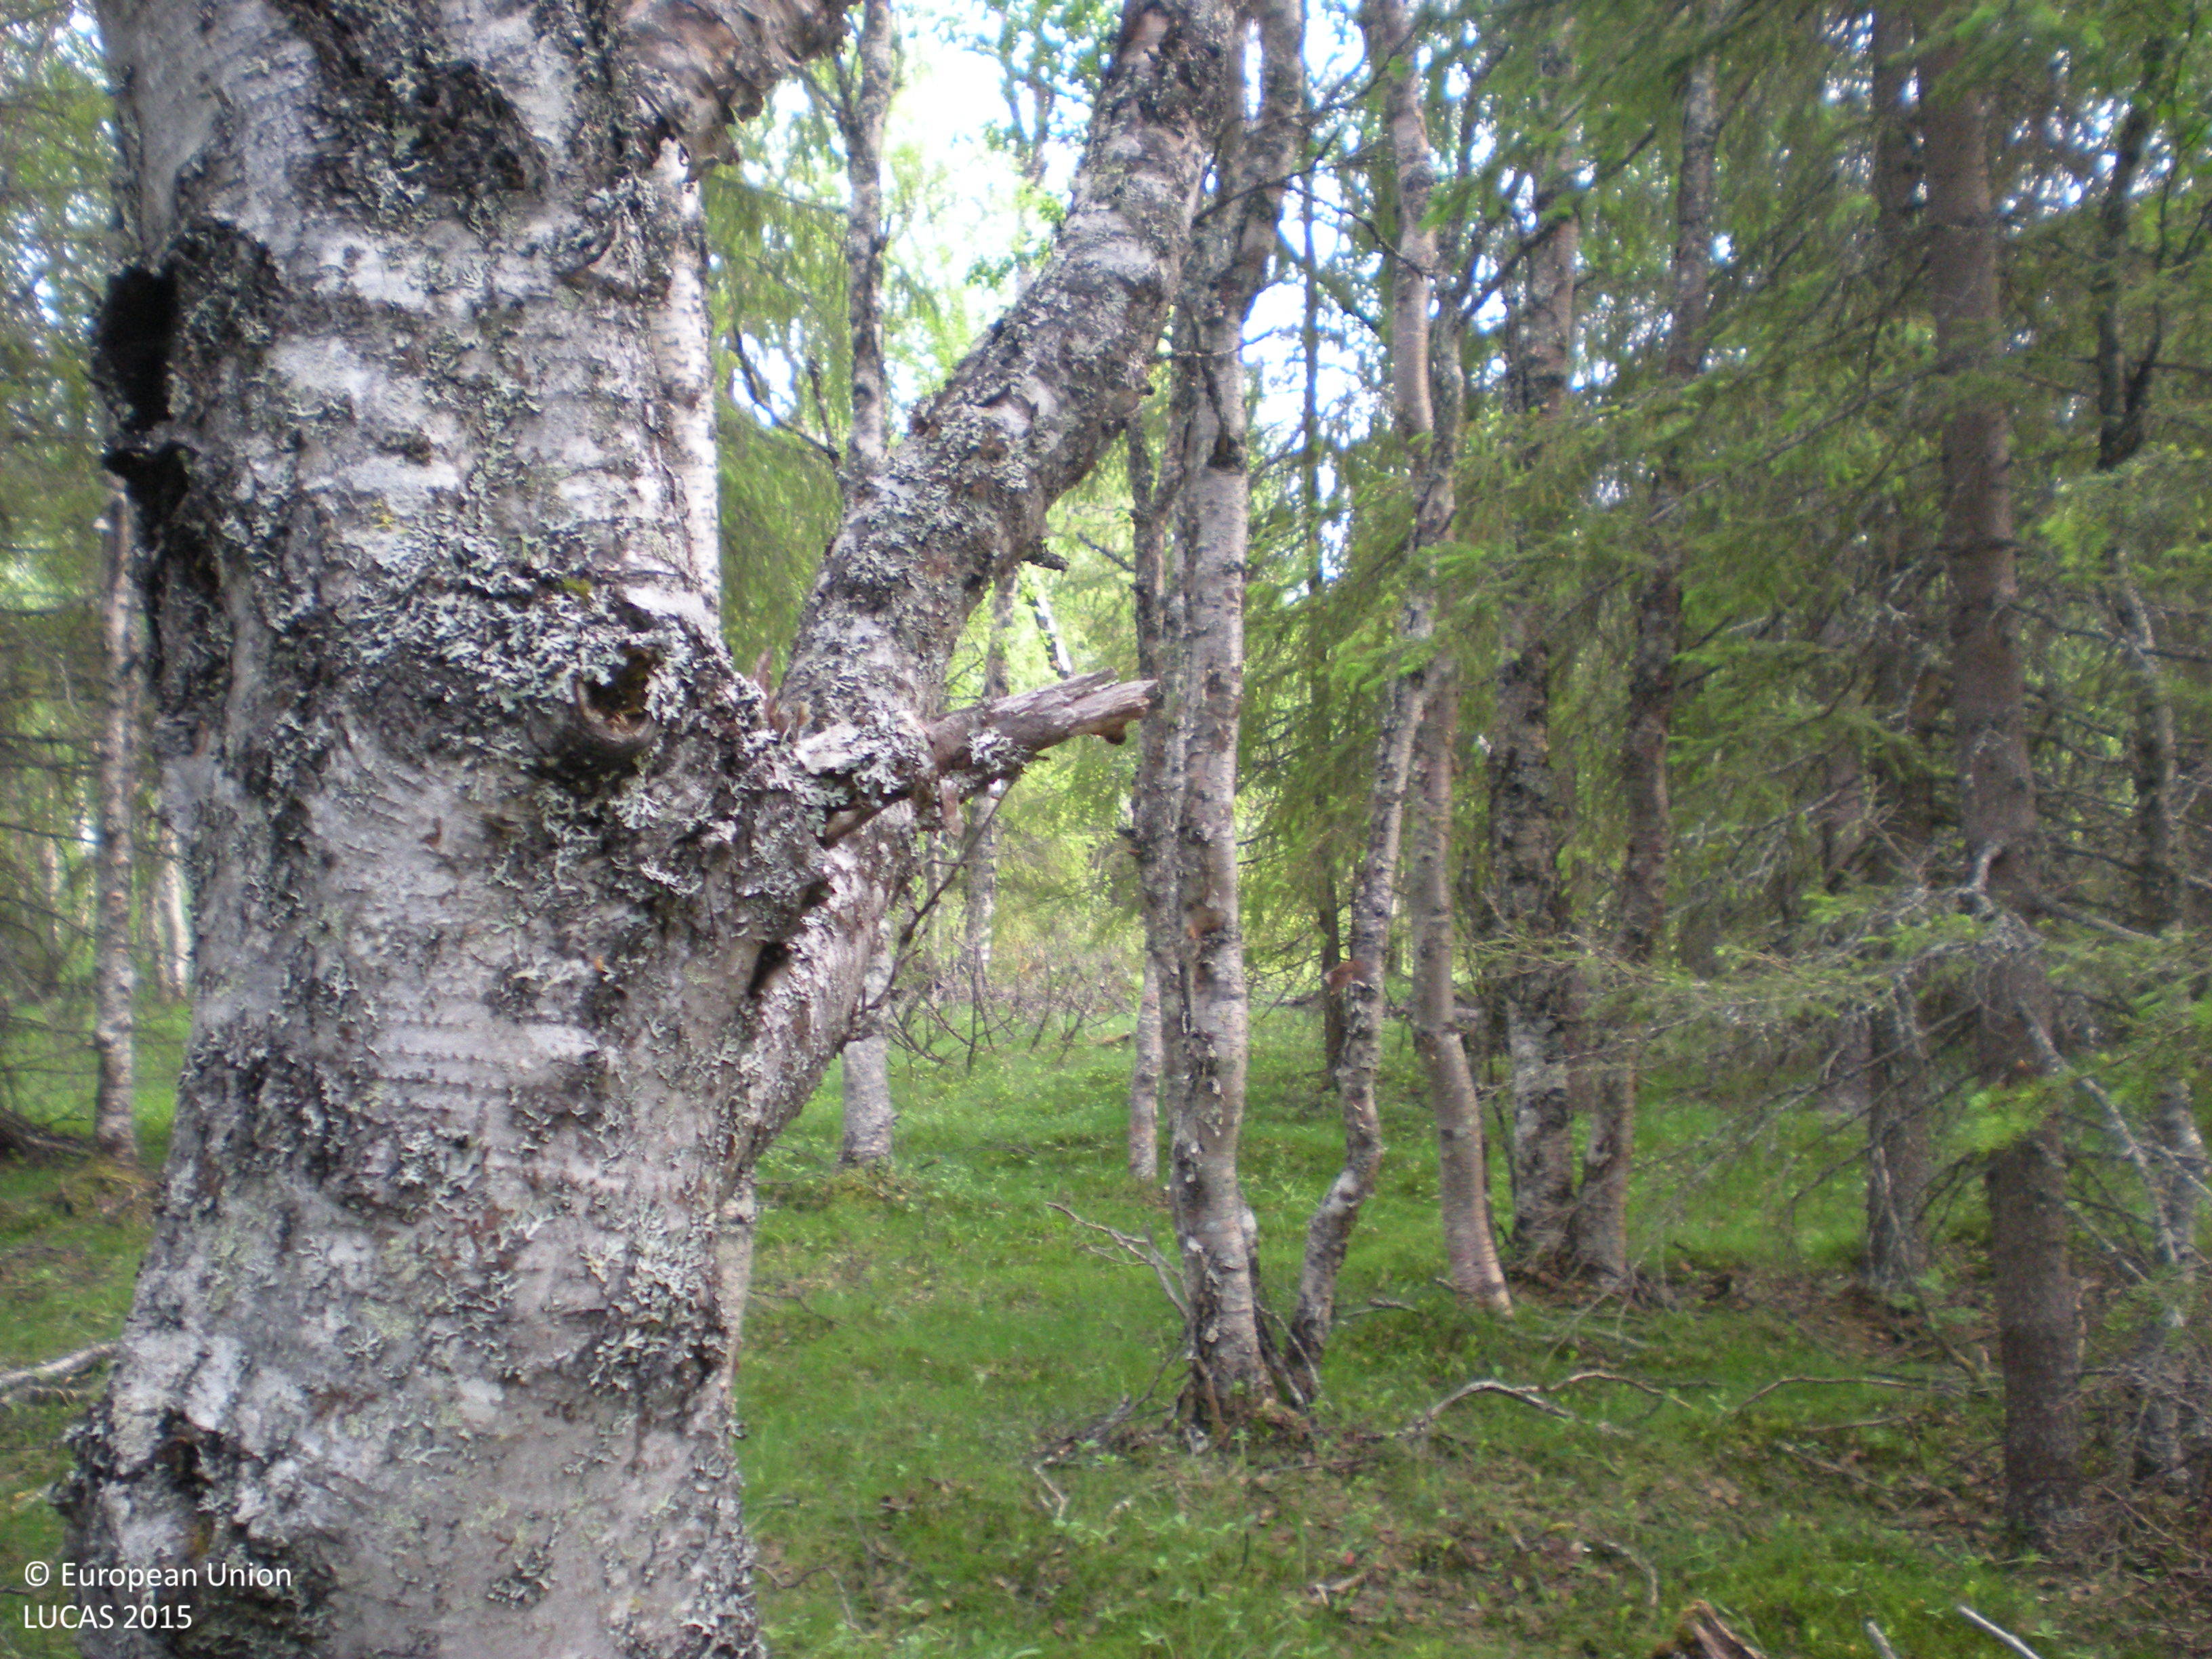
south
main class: Woodland
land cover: Spruce dominated mixed woodland
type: boreal forest
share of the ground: 50 - 75 %
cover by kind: coniferous forest trees 45 %, broadleaved forest trees 30 %, herbaceous plants 15 %, shrubs 5 %, lichens and mosses 5 %
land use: Forestry
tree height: > 5 m
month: July
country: SE
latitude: 65.6959
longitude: 16.9922
